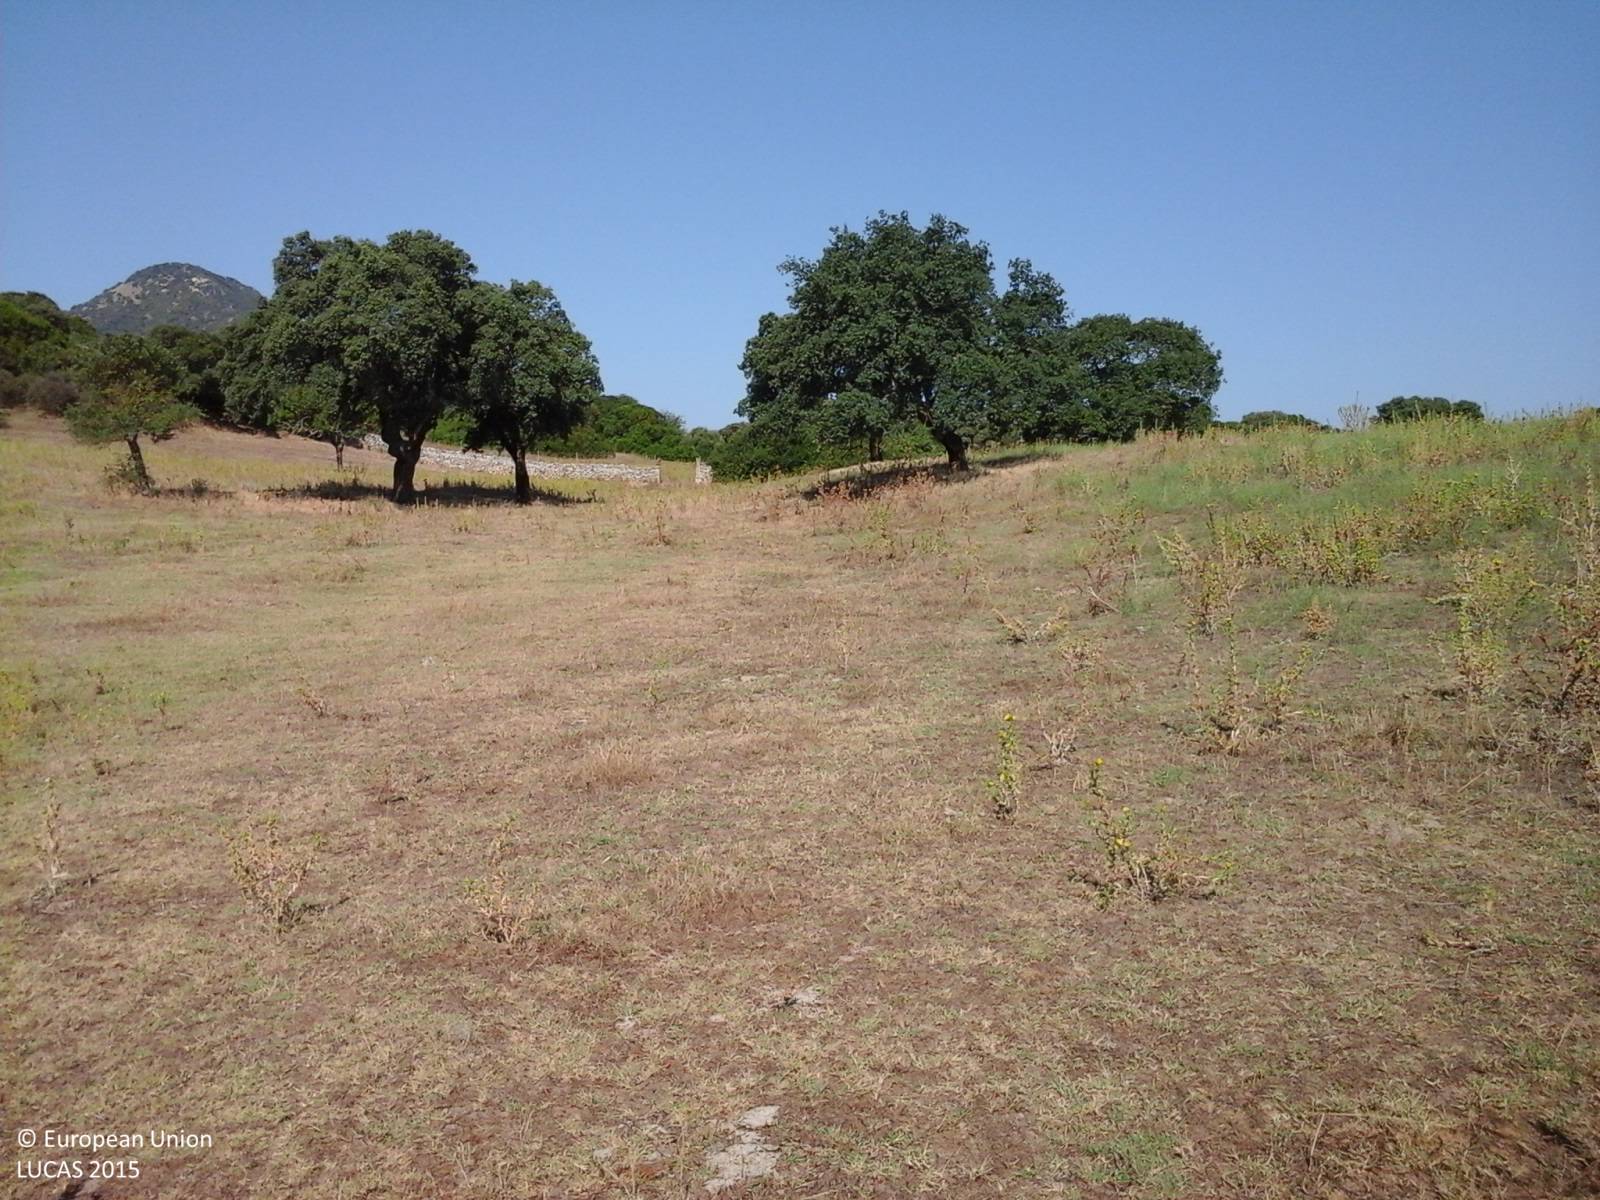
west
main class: Grassland
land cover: Grassland without tree/shrub cover
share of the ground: > 75 %
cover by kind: herbaceous plants 100 %
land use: Agriculture (excluding fallow land and kitchen gardens)
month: July
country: IT
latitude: 40.5860
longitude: 8.8126
